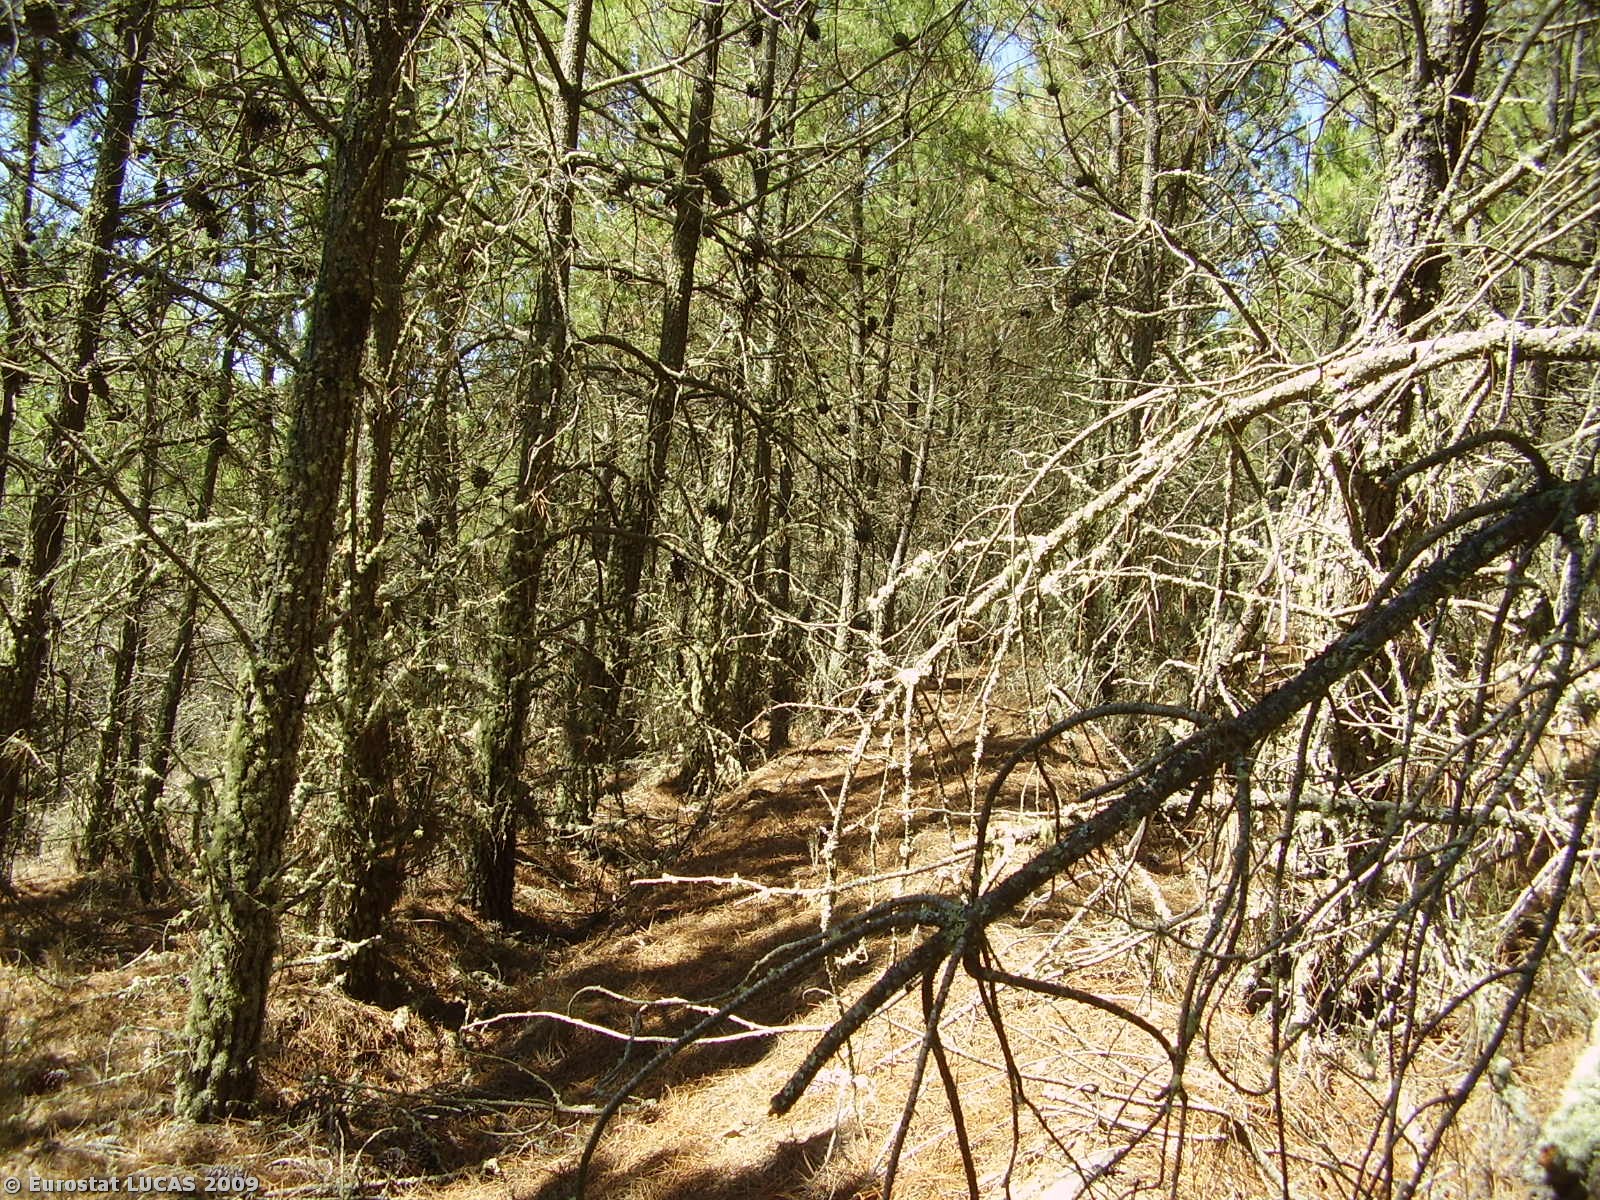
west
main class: Woodland
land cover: Coniferous woodland
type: coniferous forest of the mediterranean region
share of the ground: 10 - 25 %
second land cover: Bare land
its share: > 75 %
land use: Forestry
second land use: Fallow land
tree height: > 5 m
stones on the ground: > 50 %
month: August
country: PT
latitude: 41.2081
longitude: -6.7652
